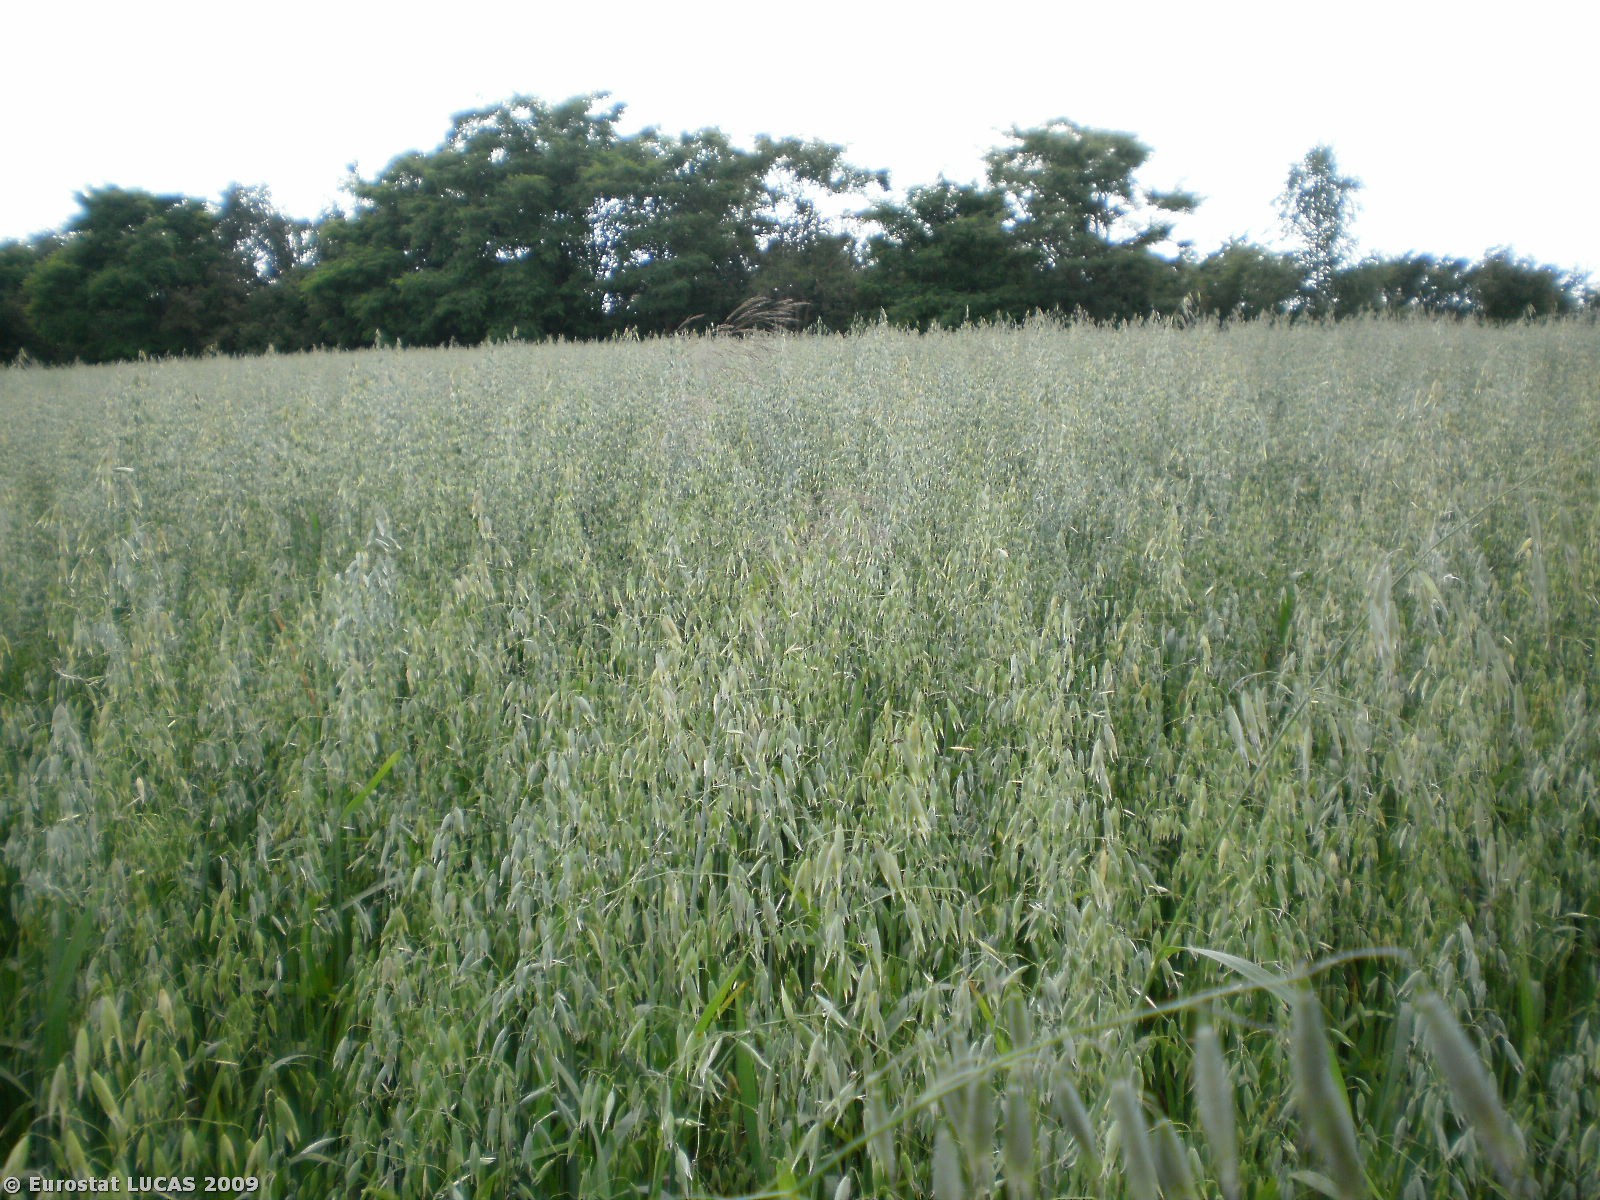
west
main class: Cropland
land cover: Oats
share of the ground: > 75 %
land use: Agriculture (excluding fallow land and kitchen gardens)
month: July
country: PL
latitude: 53.3300
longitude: 20.4424
